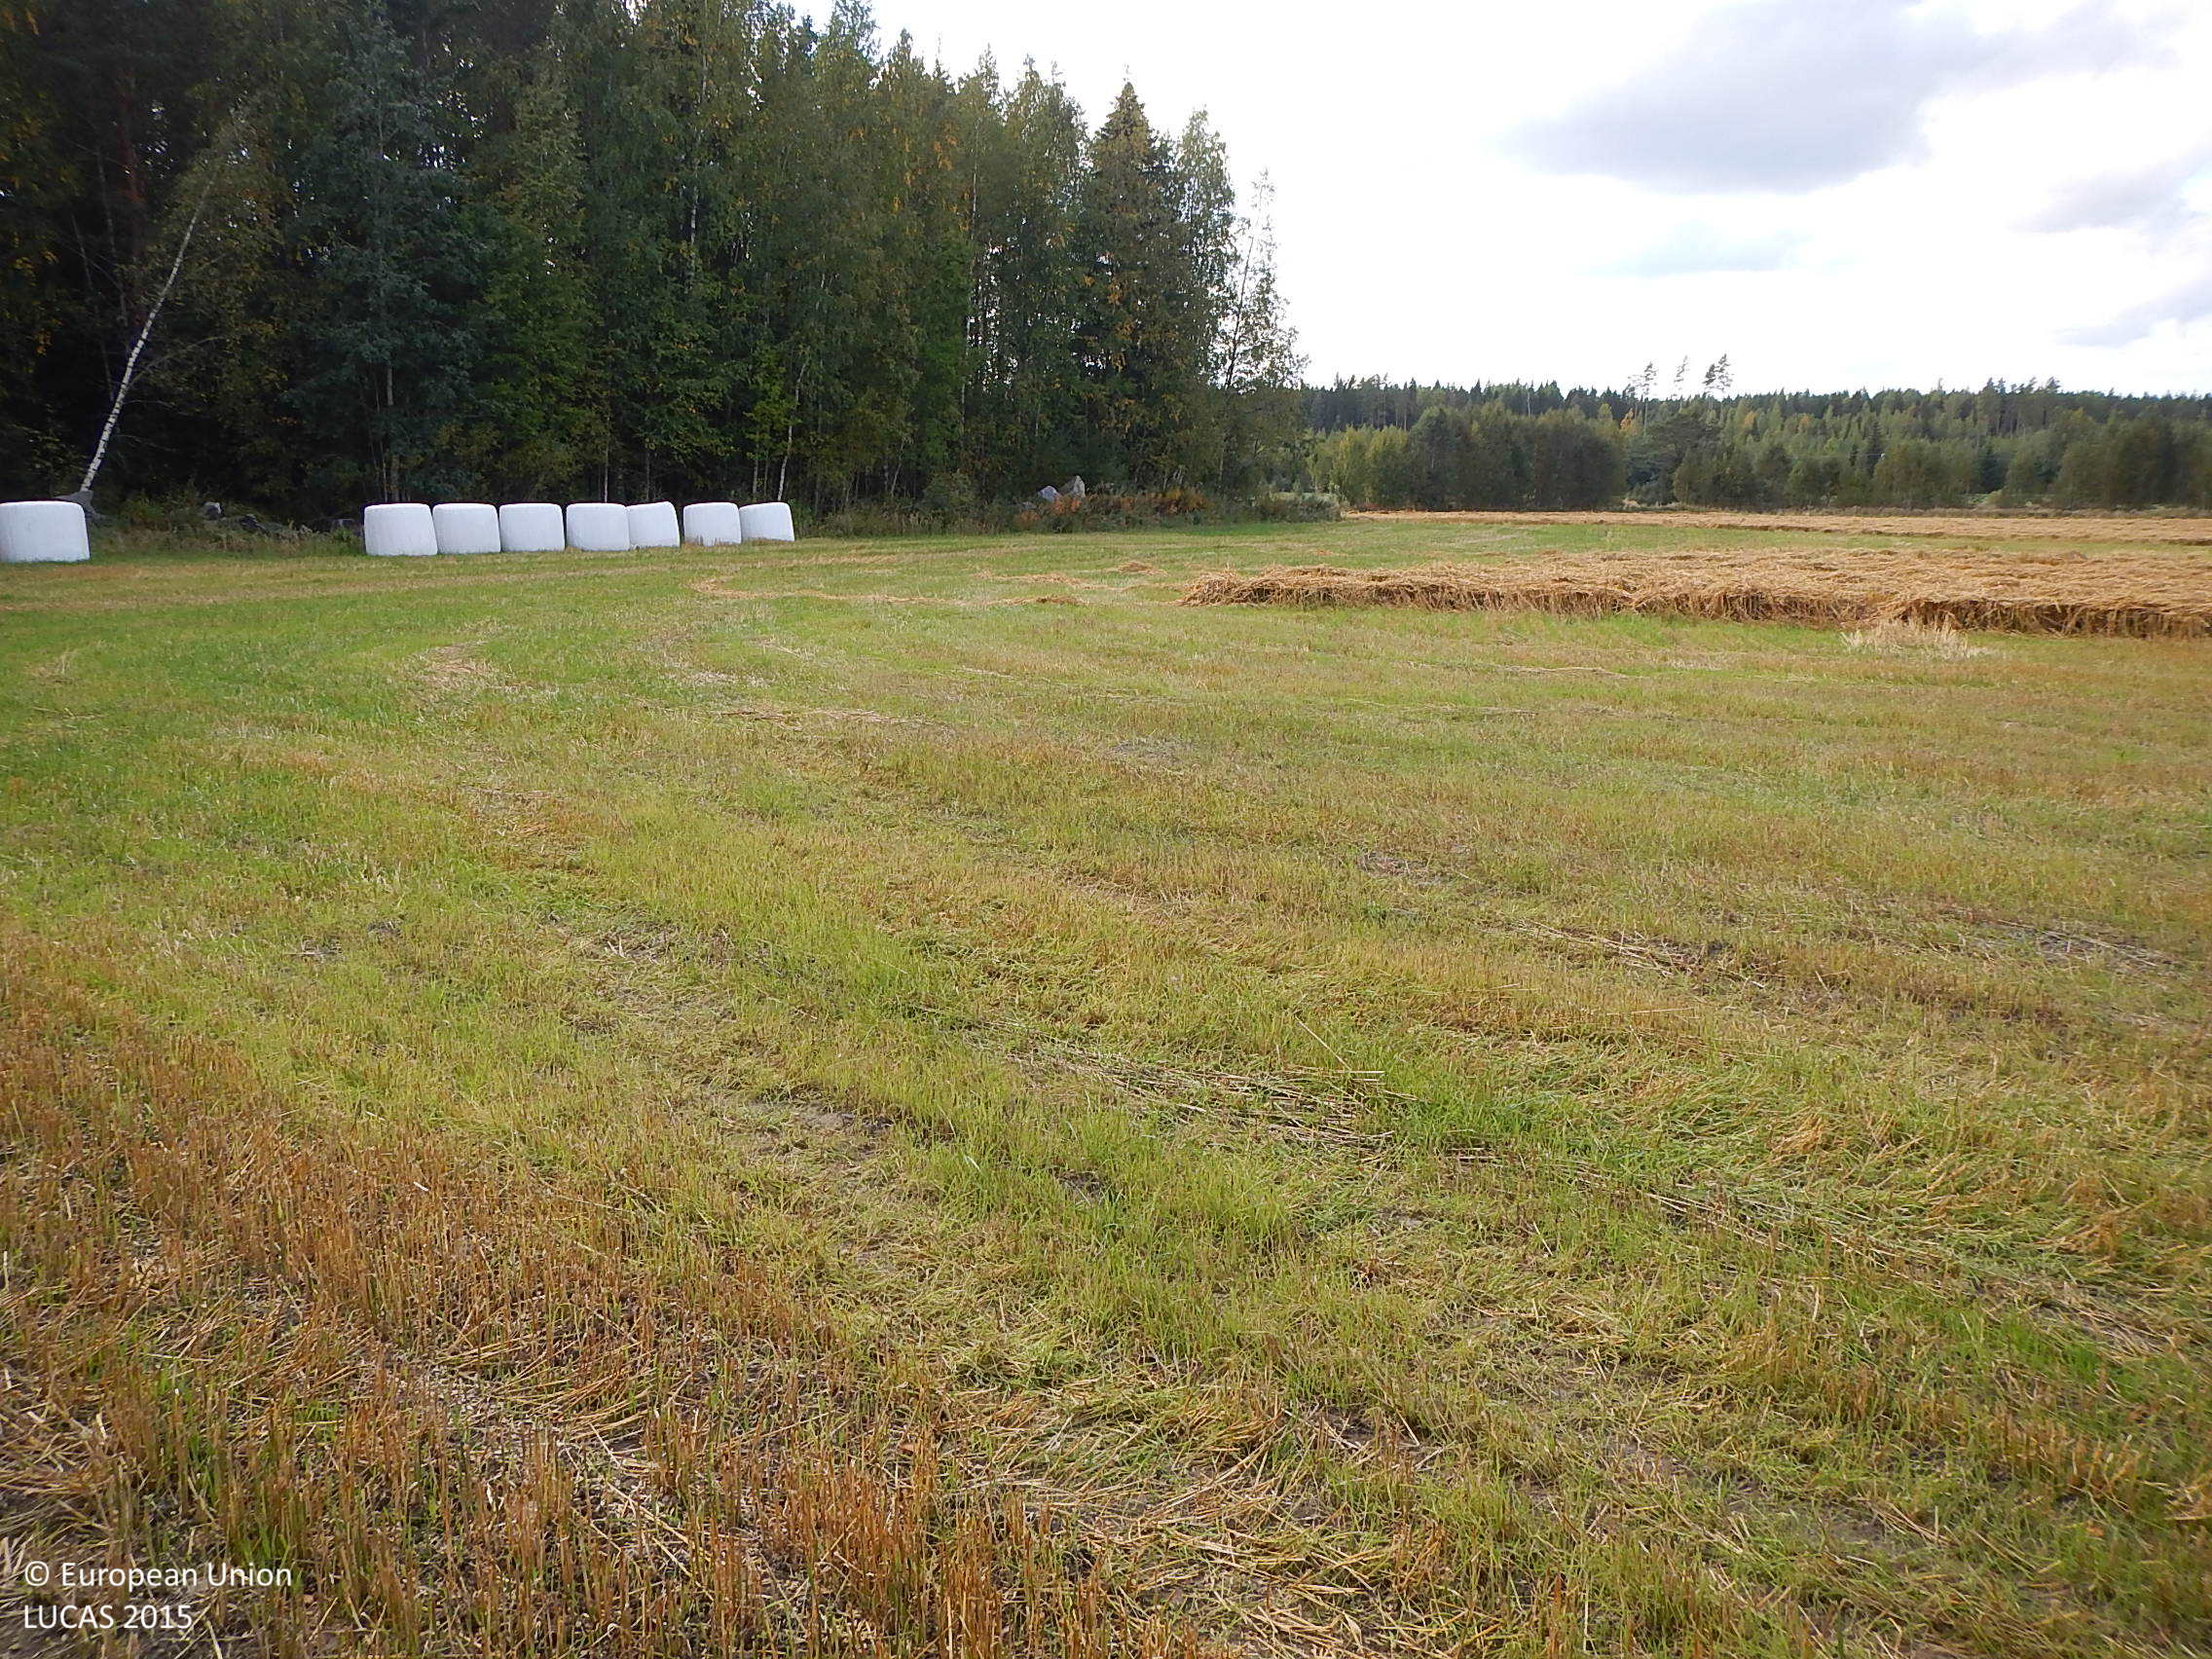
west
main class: Cropland
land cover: Oats
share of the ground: > 75 %
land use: Agriculture (excluding fallow land and kitchen gardens)
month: September
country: FI
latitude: 61.6094
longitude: 22.3335
